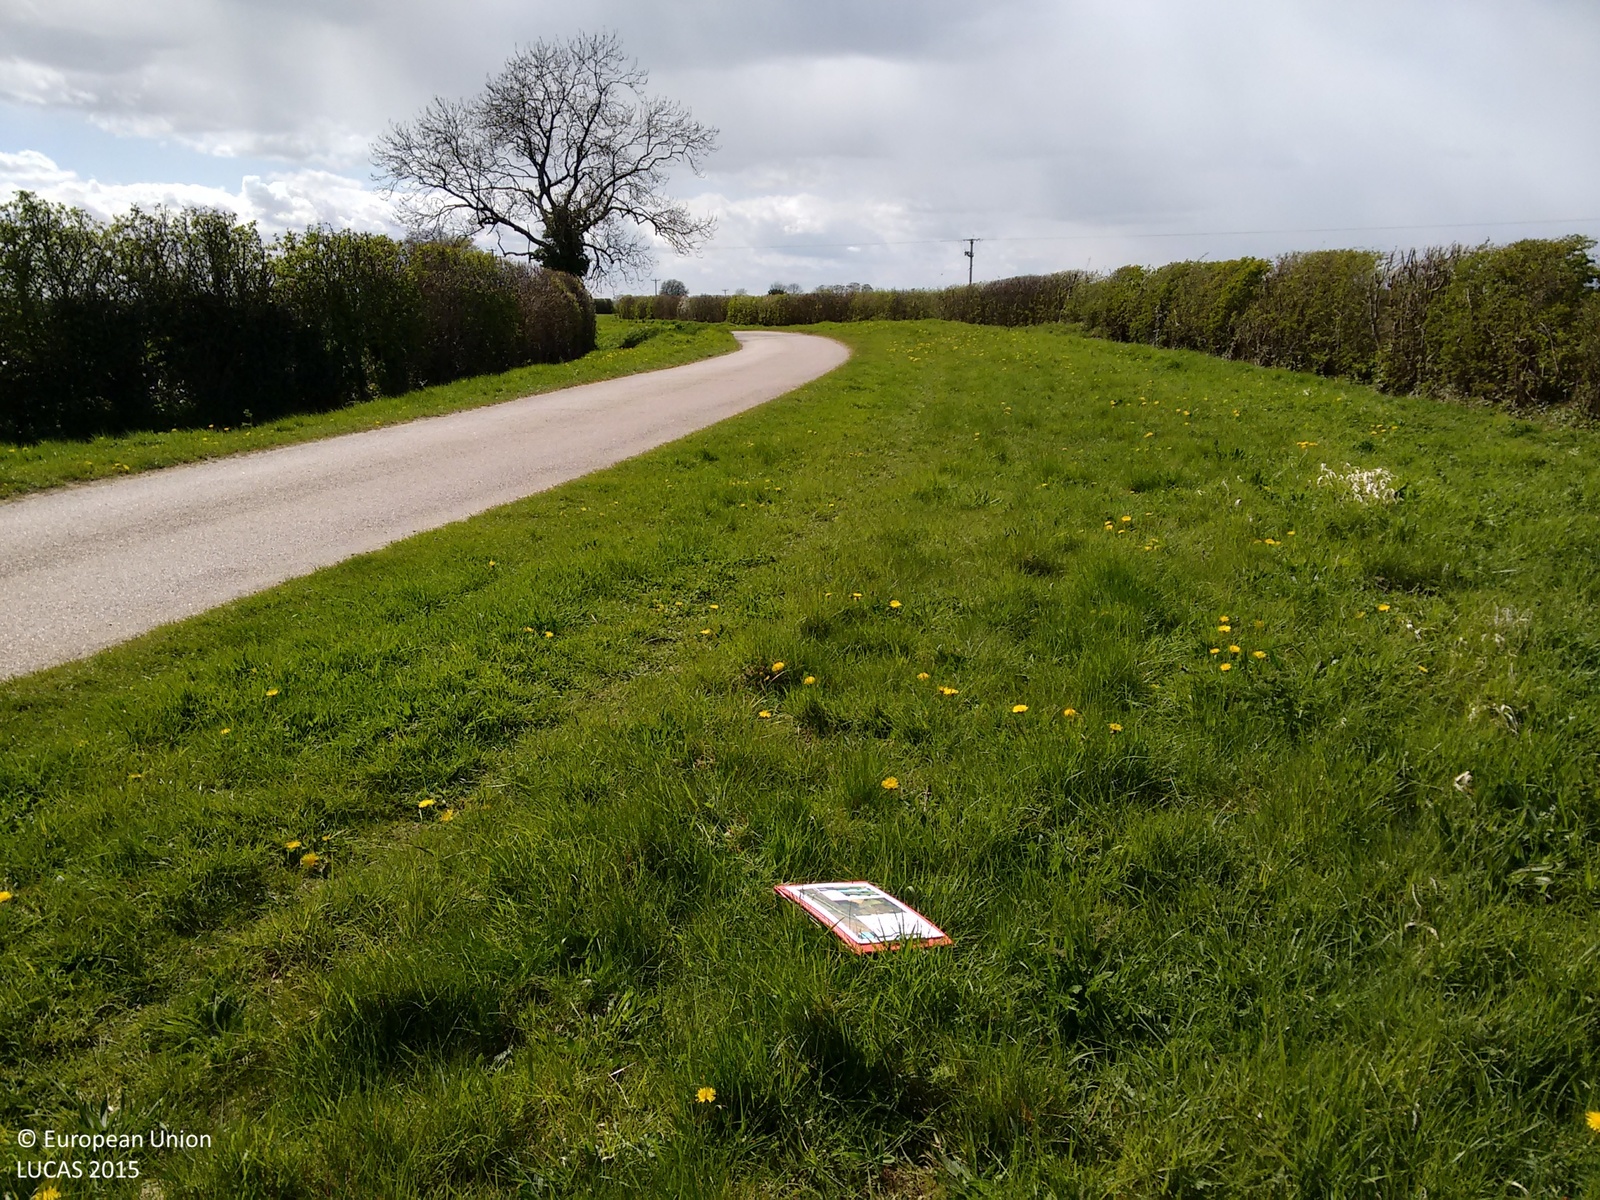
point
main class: Grassland
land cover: Grassland without tree/shrub cover
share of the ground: > 75 %
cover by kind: herbaceous plants 100 %
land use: Road transport
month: April
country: GB
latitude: 53.1575
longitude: -0.1281
